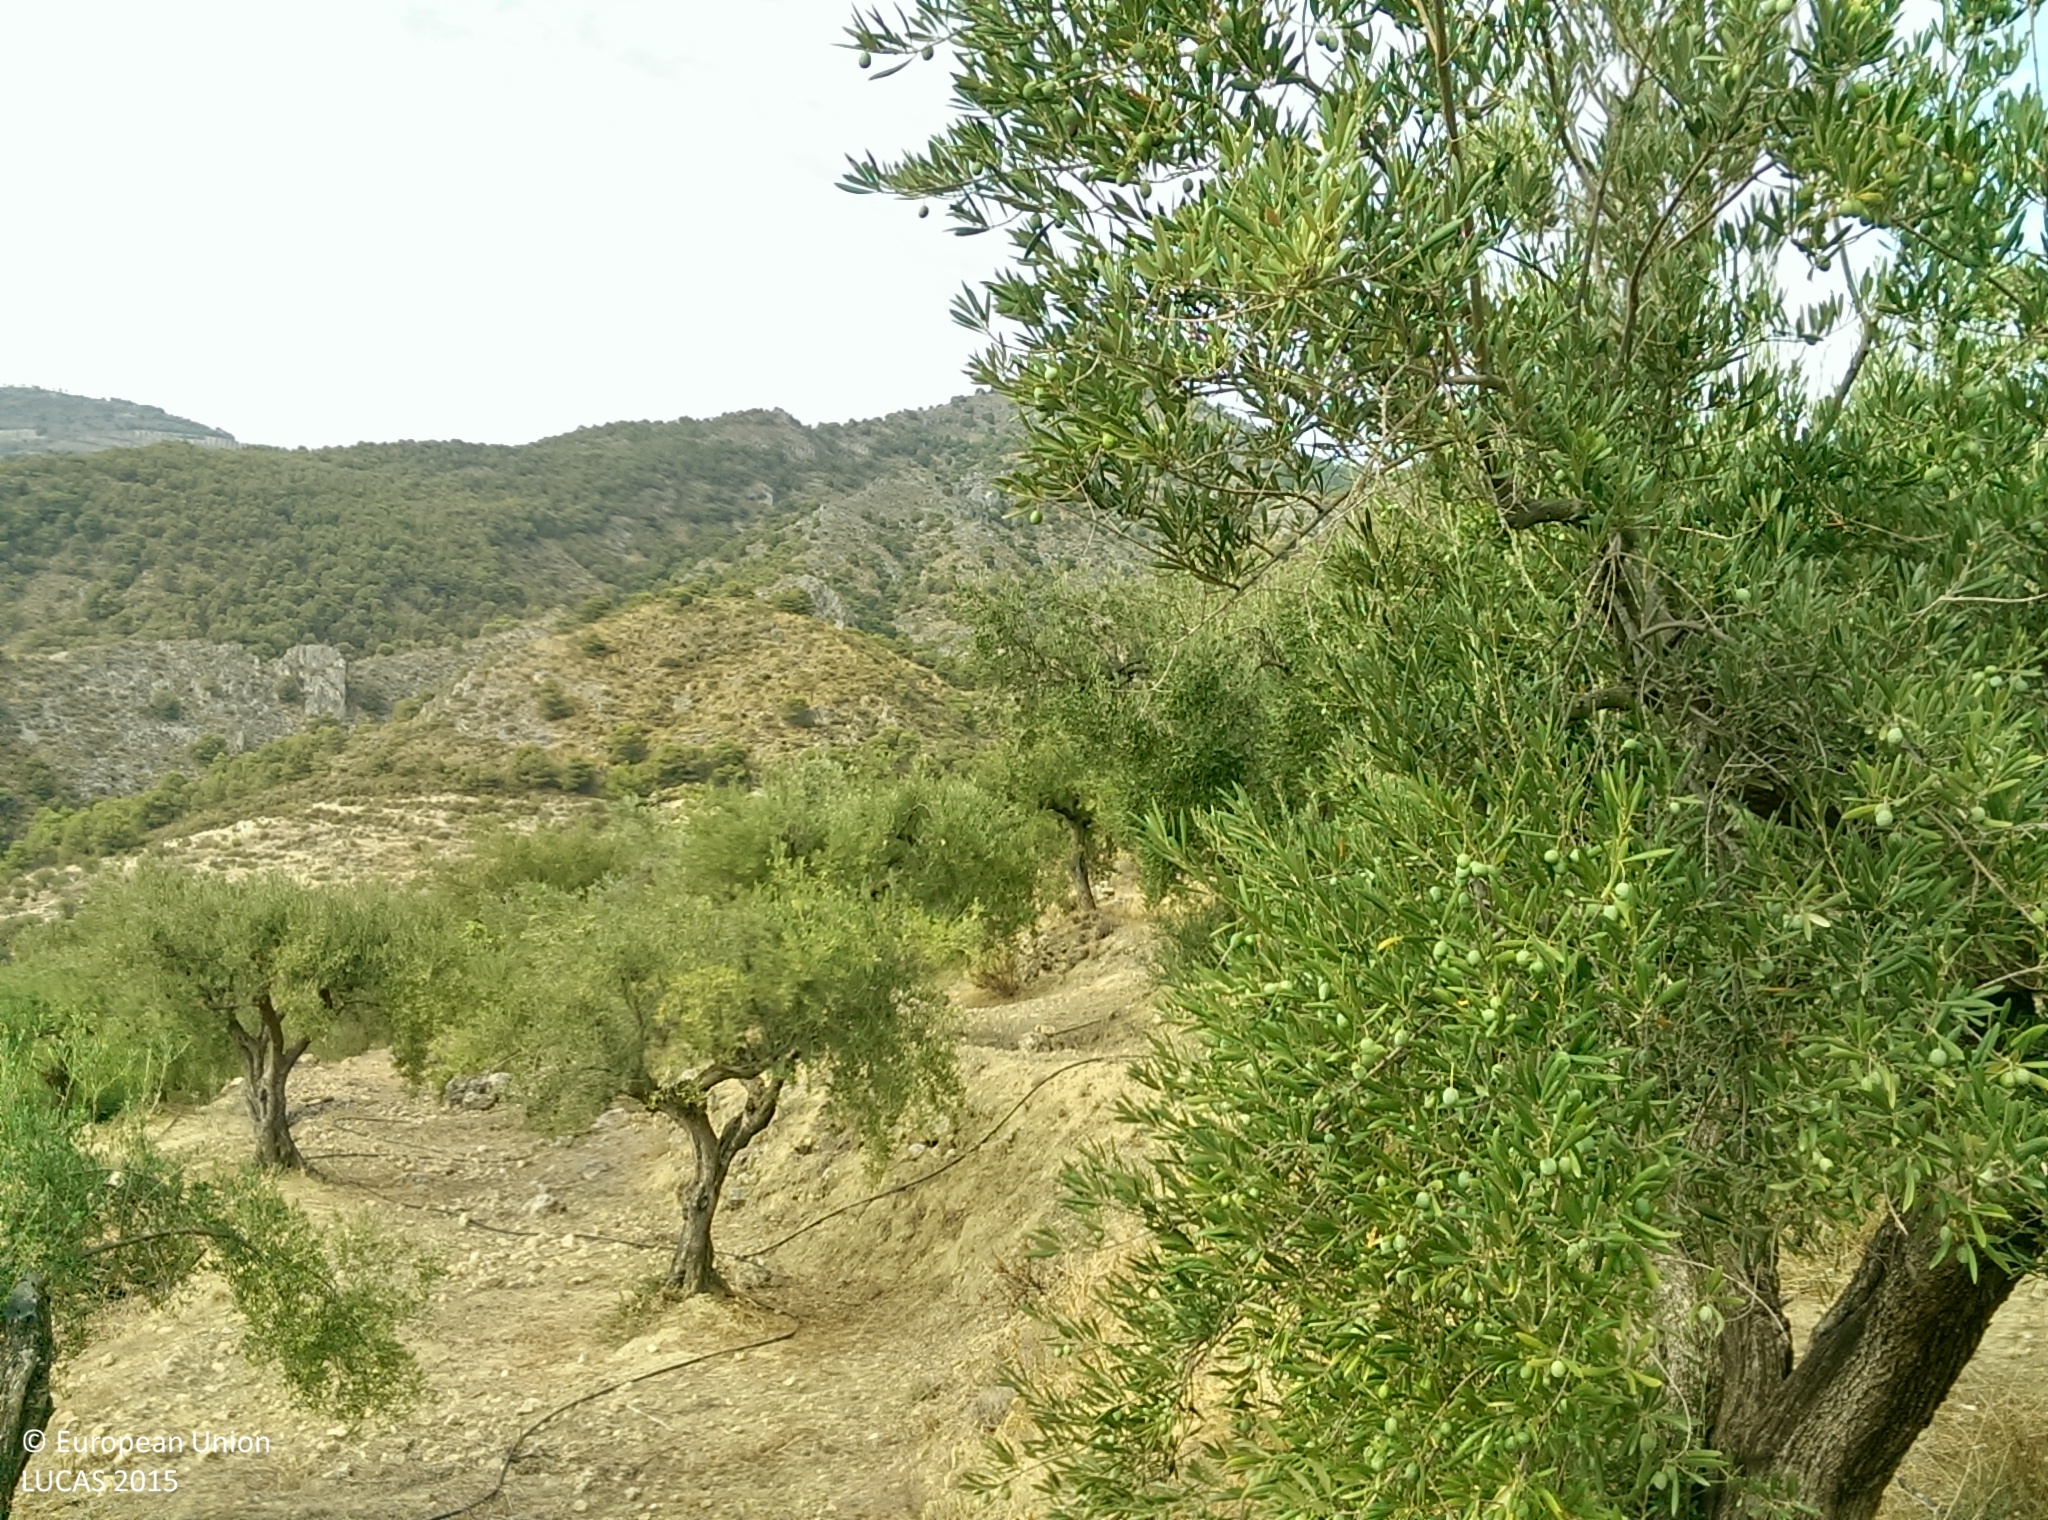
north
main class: Cropland
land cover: Olive groves
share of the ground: 50 - 75 %
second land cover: Spontaneously vegetated surfaces
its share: 50 - 75 %
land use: Agriculture (excluding fallow land and kitchen gardens)
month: August
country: ES
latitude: 36.8589
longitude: -3.5893
